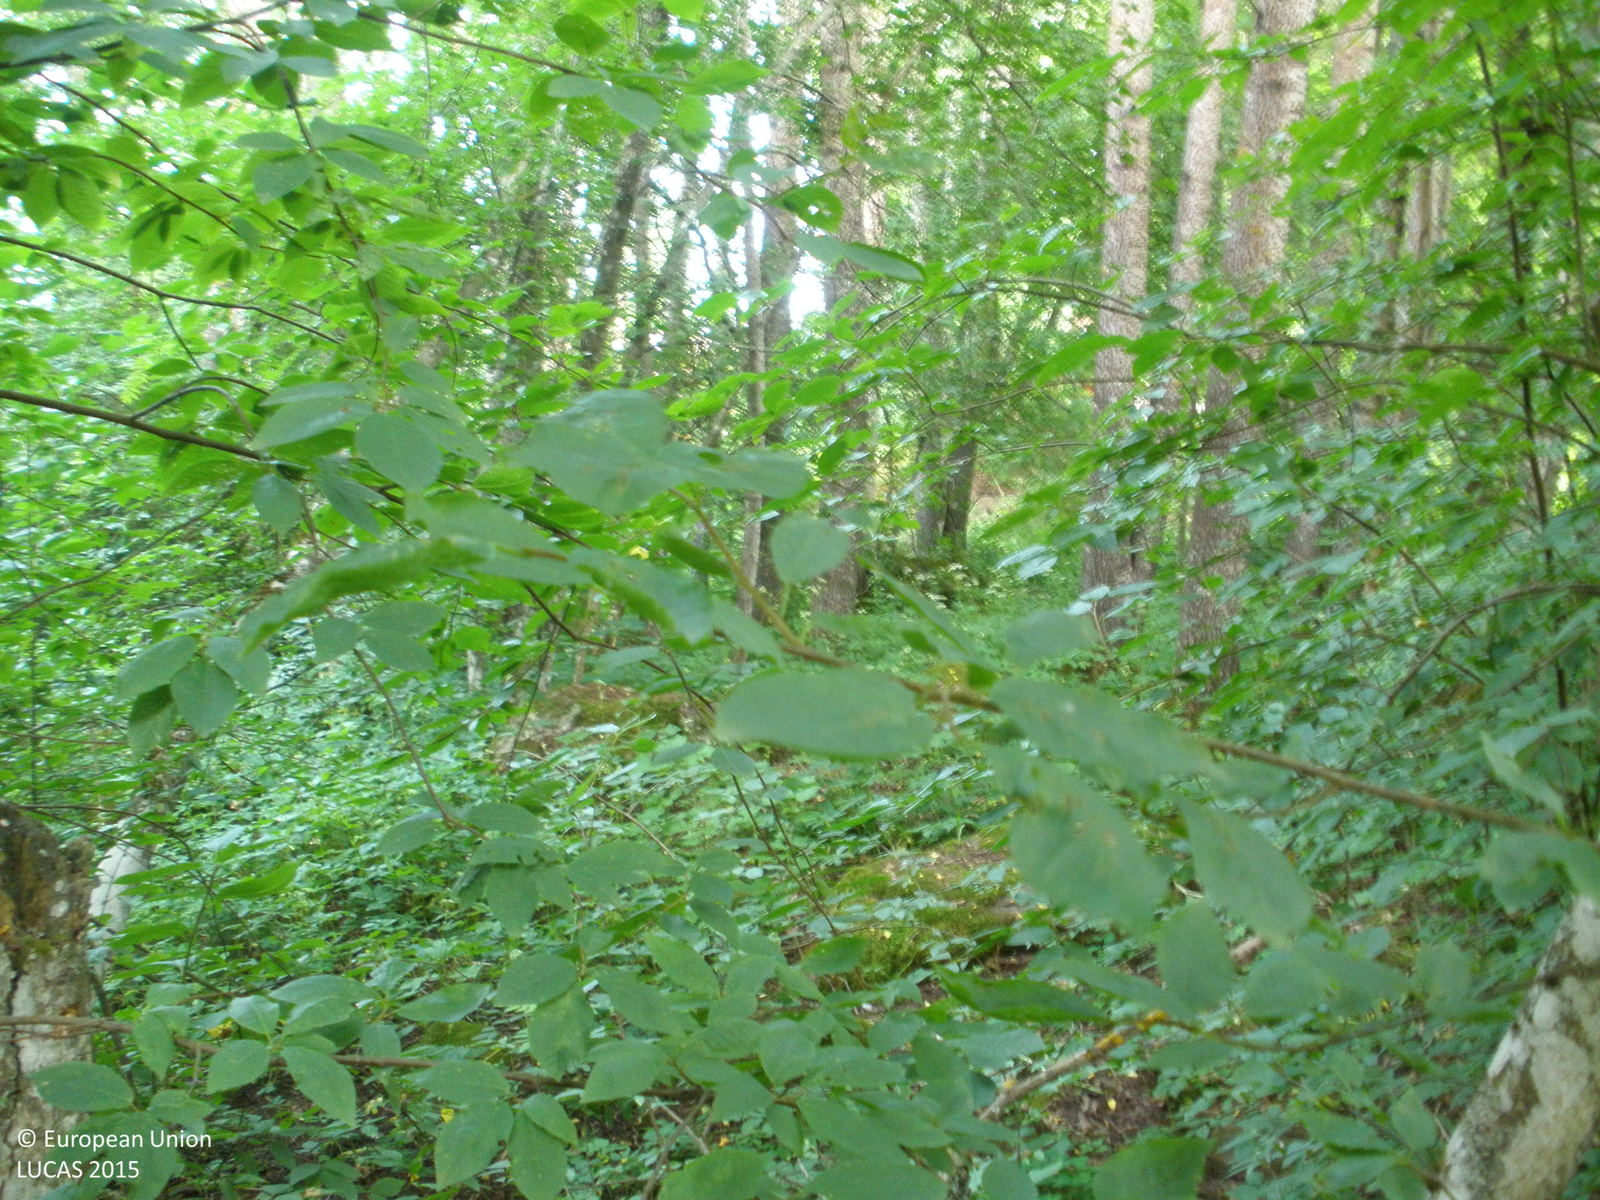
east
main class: Woodland
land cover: Broadleaved woodland
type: non-riverine alder, birch or aspen forest
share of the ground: > 75 %
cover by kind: broadleaved forest trees 85 %, herbaceous plants 10 %, shrubs 5 %
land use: Forestry
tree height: > 5 m
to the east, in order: Broadleaved woodland; Electric lines; Broadleaved woodland; Tracks; Grass margins; Tracks; Broadleaved woodland; Grass margins; Arable land (only in case pi); Ditches and canals; Arable land (only in case pi)
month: June
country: FI
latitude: 61.1718
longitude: 24.6616
